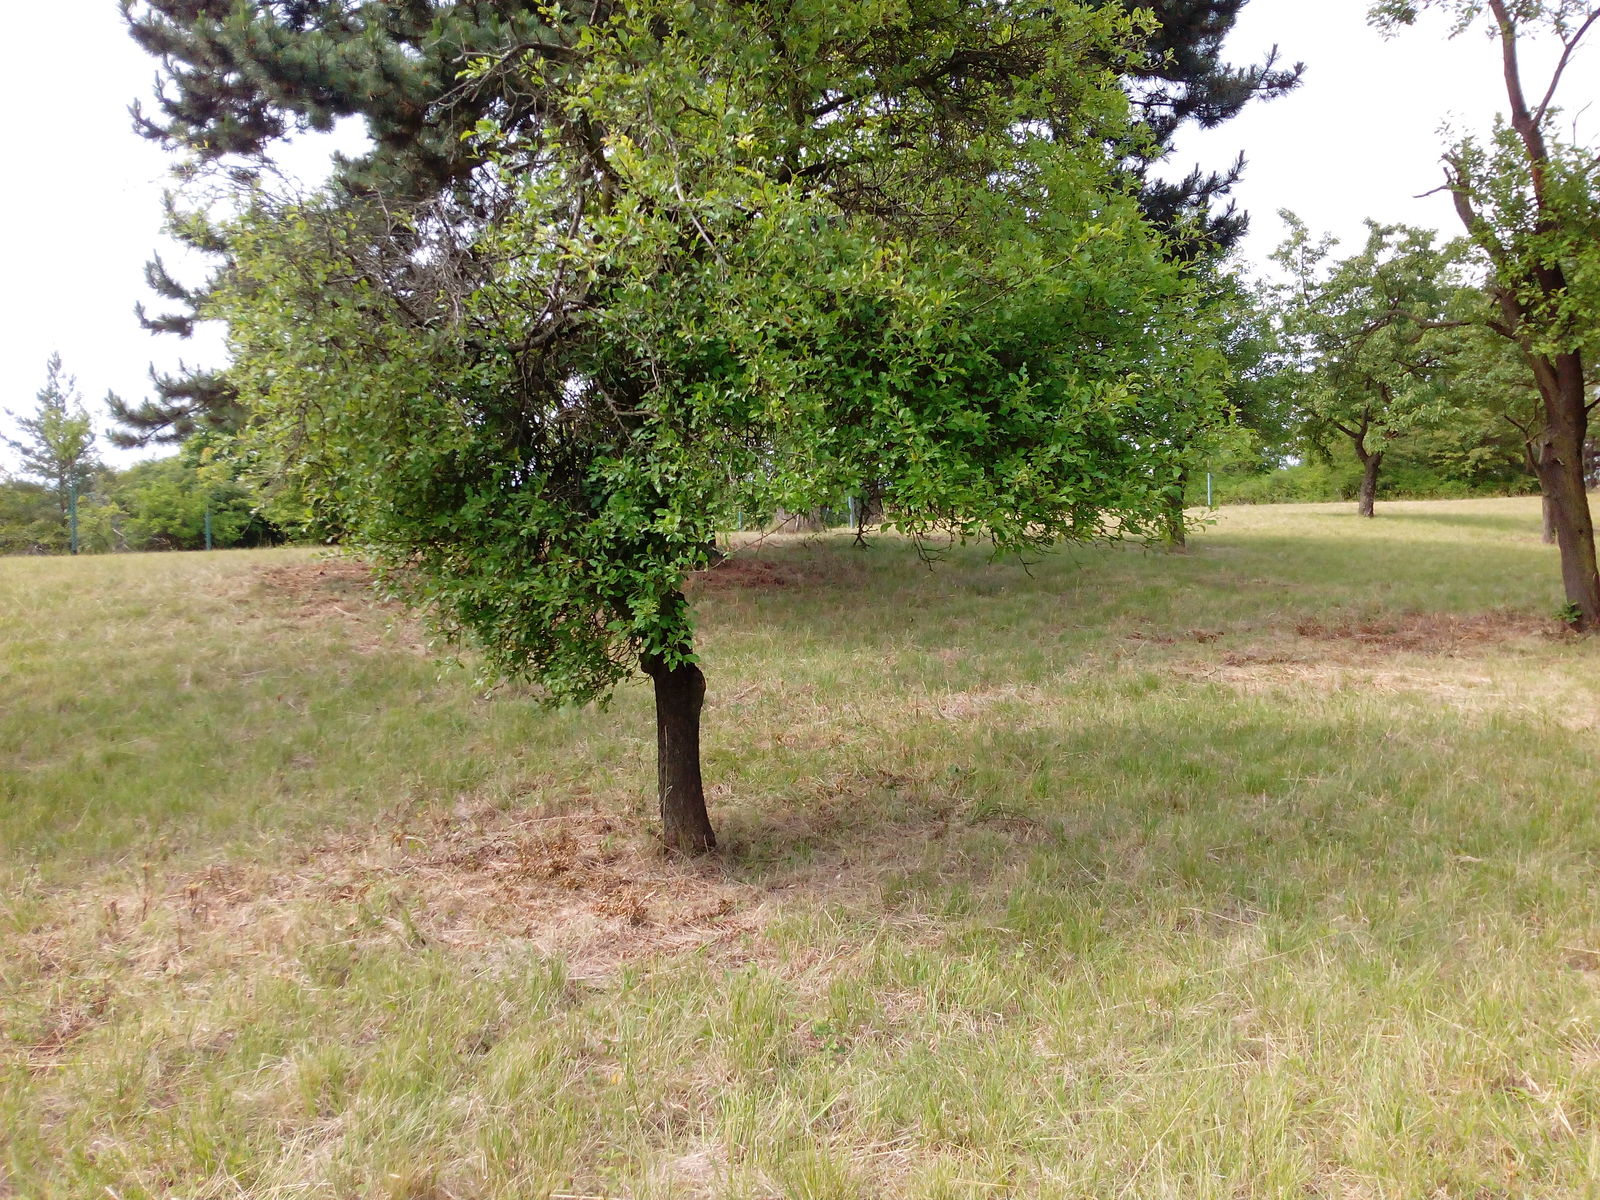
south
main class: Cropland
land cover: Apple fruit
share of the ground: 25 - 50 %
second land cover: Grassland without tree/shrub cover
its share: > 75 %
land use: Agriculture (excluding fallow land and kitchen gardens)
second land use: Amenities, museums, leisure
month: June
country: DE
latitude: 51.3656
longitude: 11.1057
